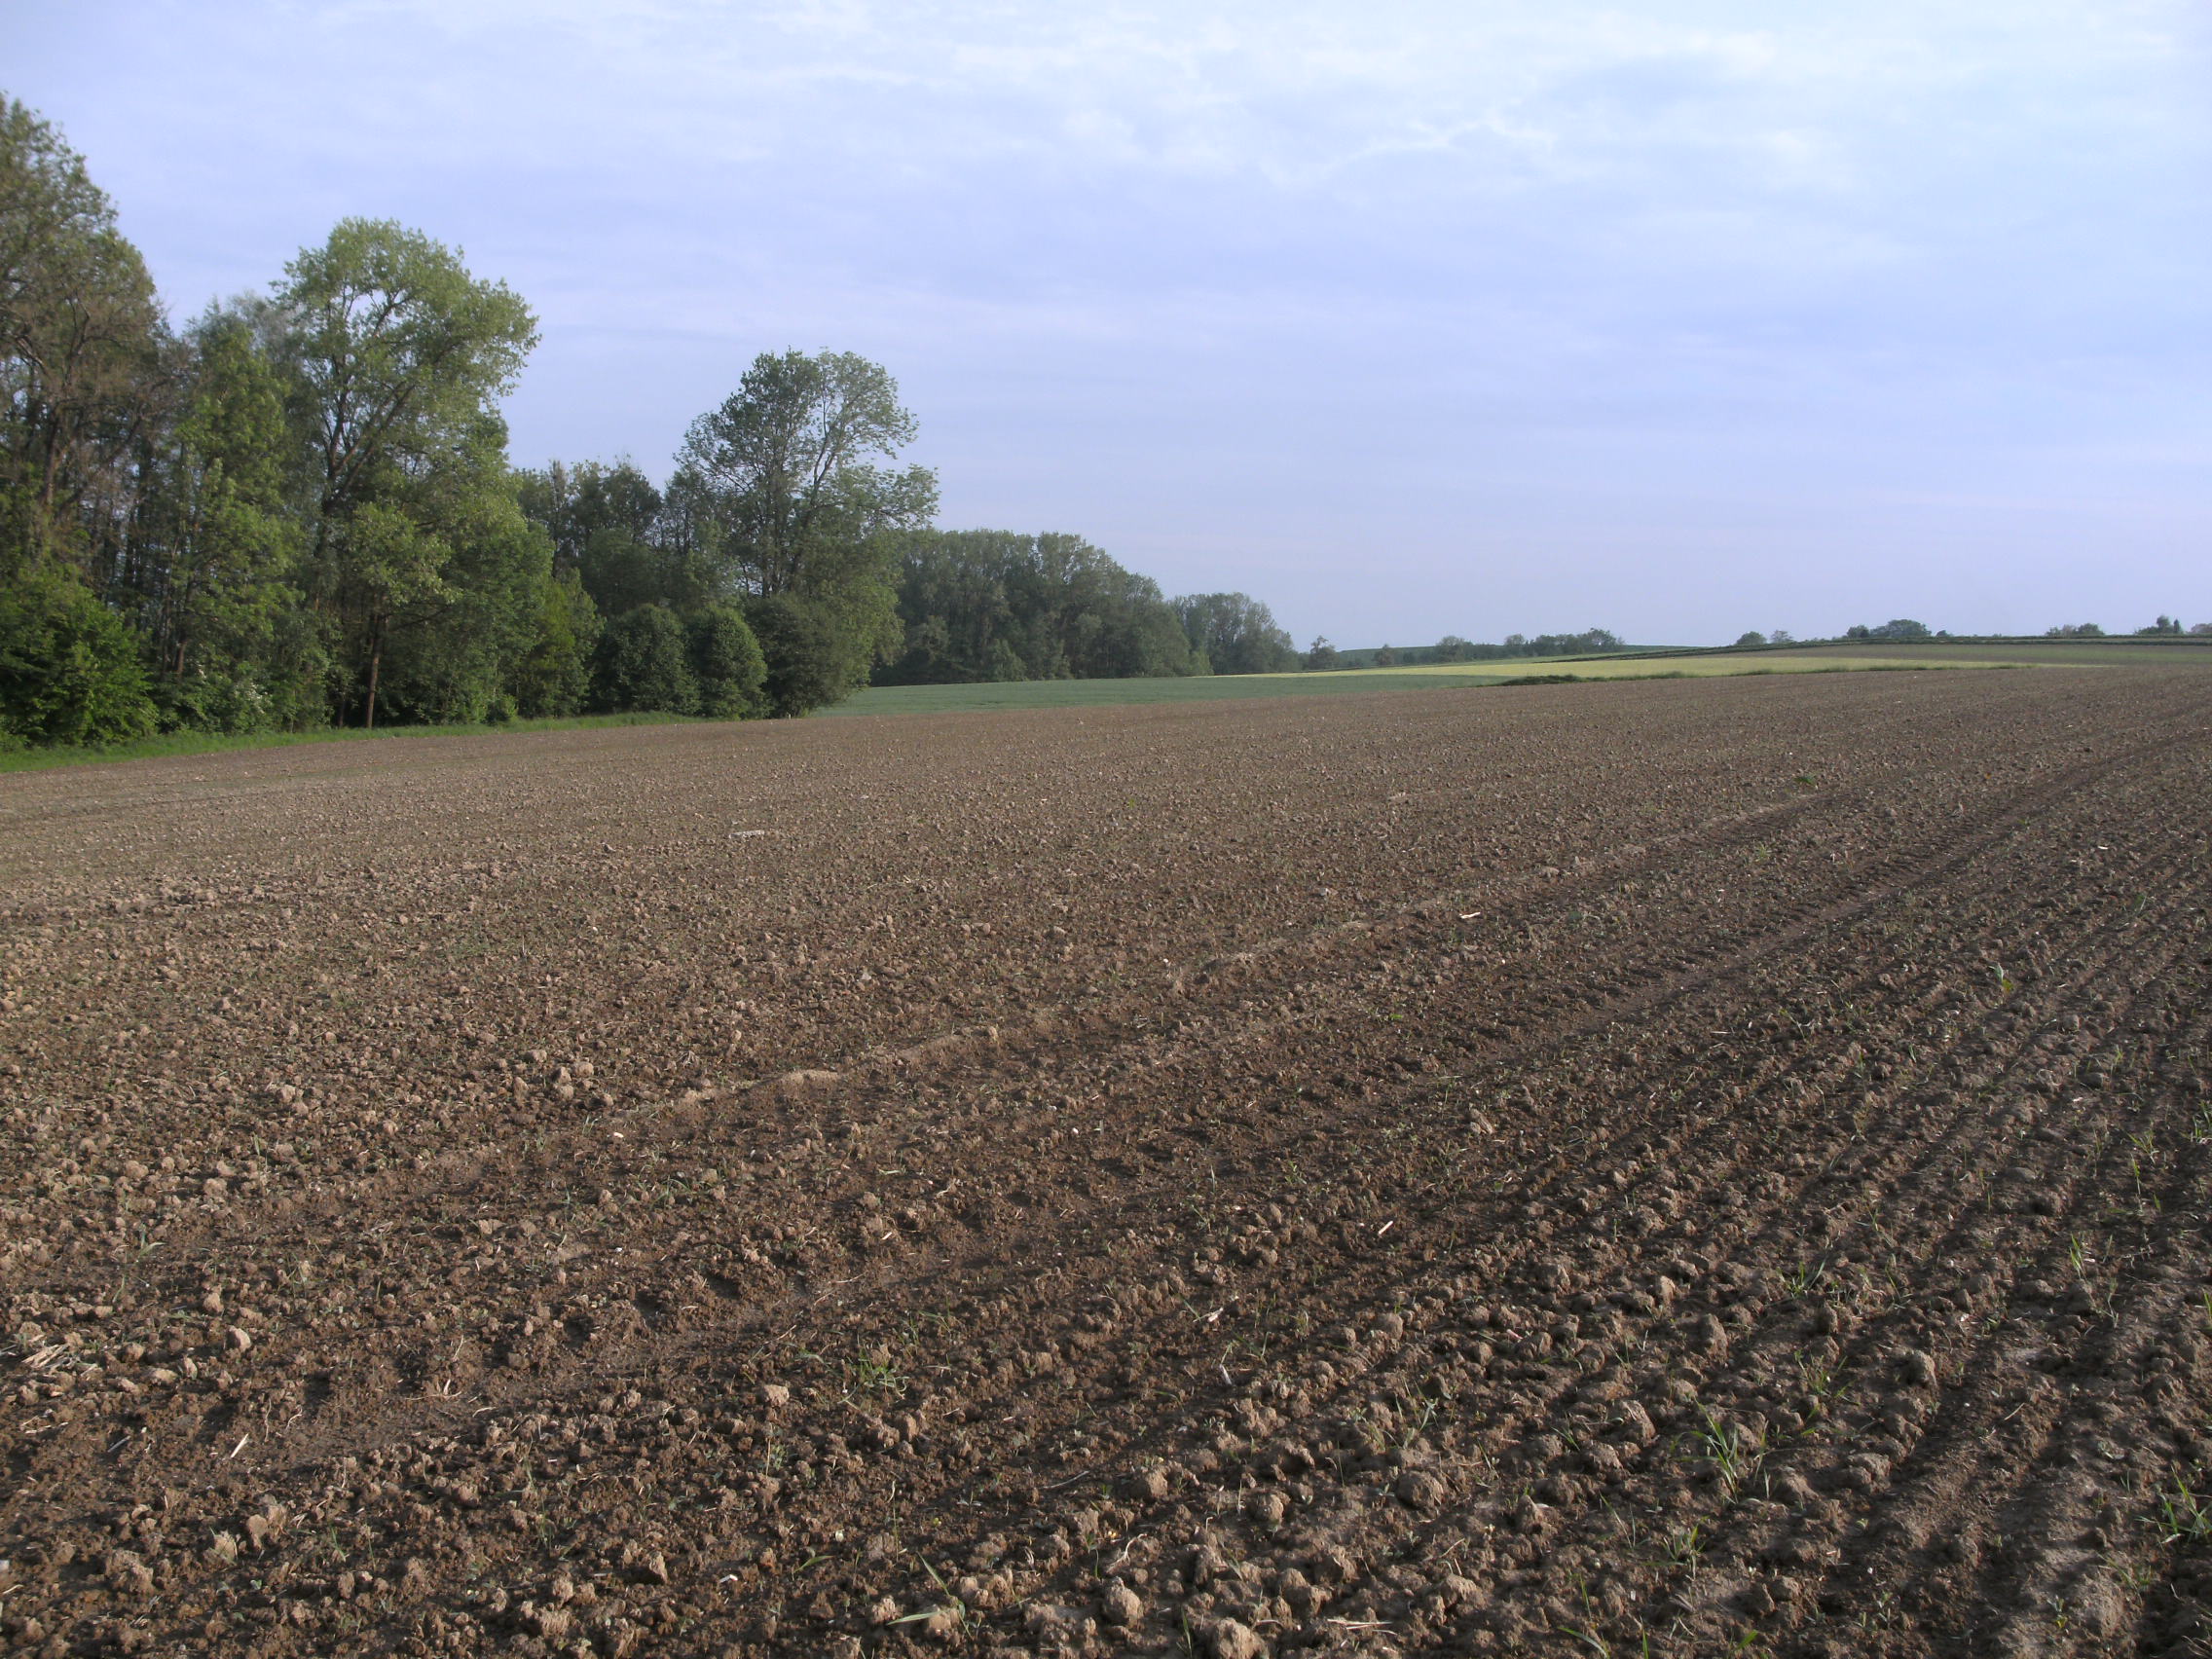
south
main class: Cropland
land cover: Soya
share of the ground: < 10 %
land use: Agriculture (excluding fallow land and kitchen gardens)
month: May
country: AT
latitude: 48.3583
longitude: 13.7380
